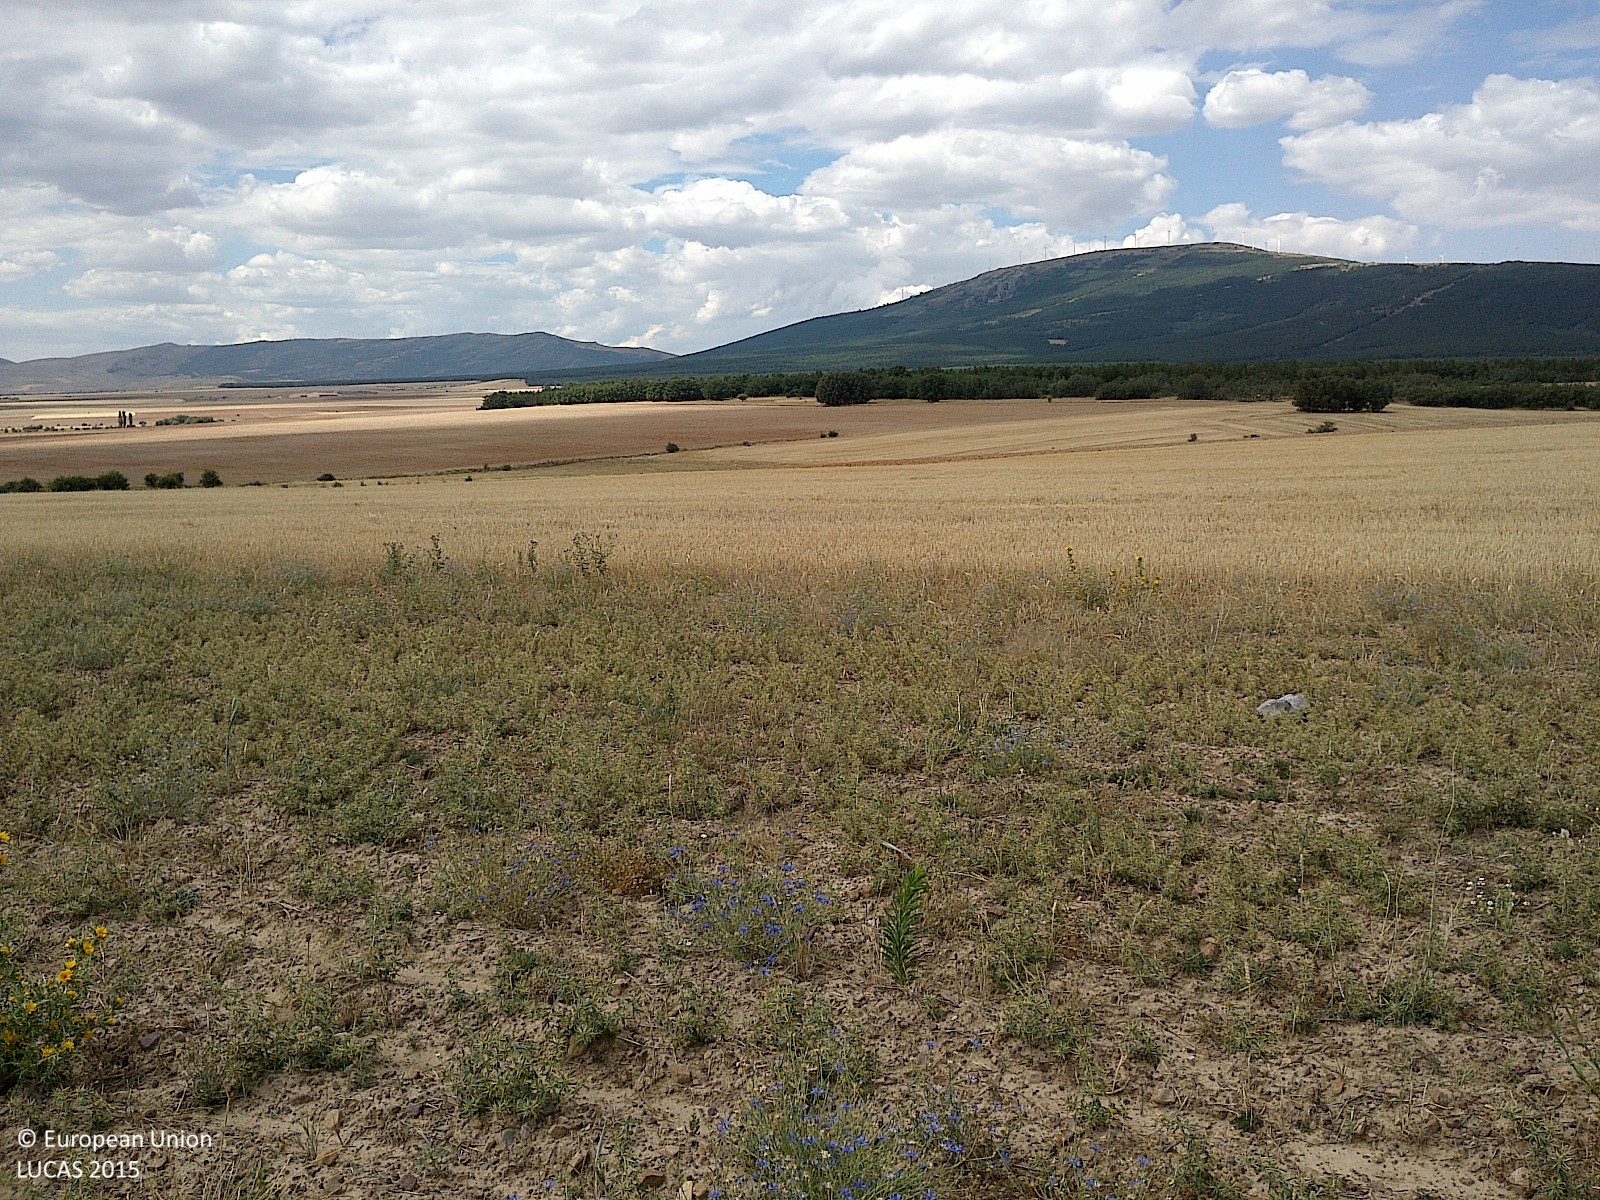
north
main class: Grassland
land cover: Spontaneously vegetated surfaces
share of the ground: 10 - 25 %
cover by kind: unconsolidated bare surface 85 %, herbaceous plants 15 %
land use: Fallow land
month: July
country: ES
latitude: 41.6721
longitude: -1.9345
